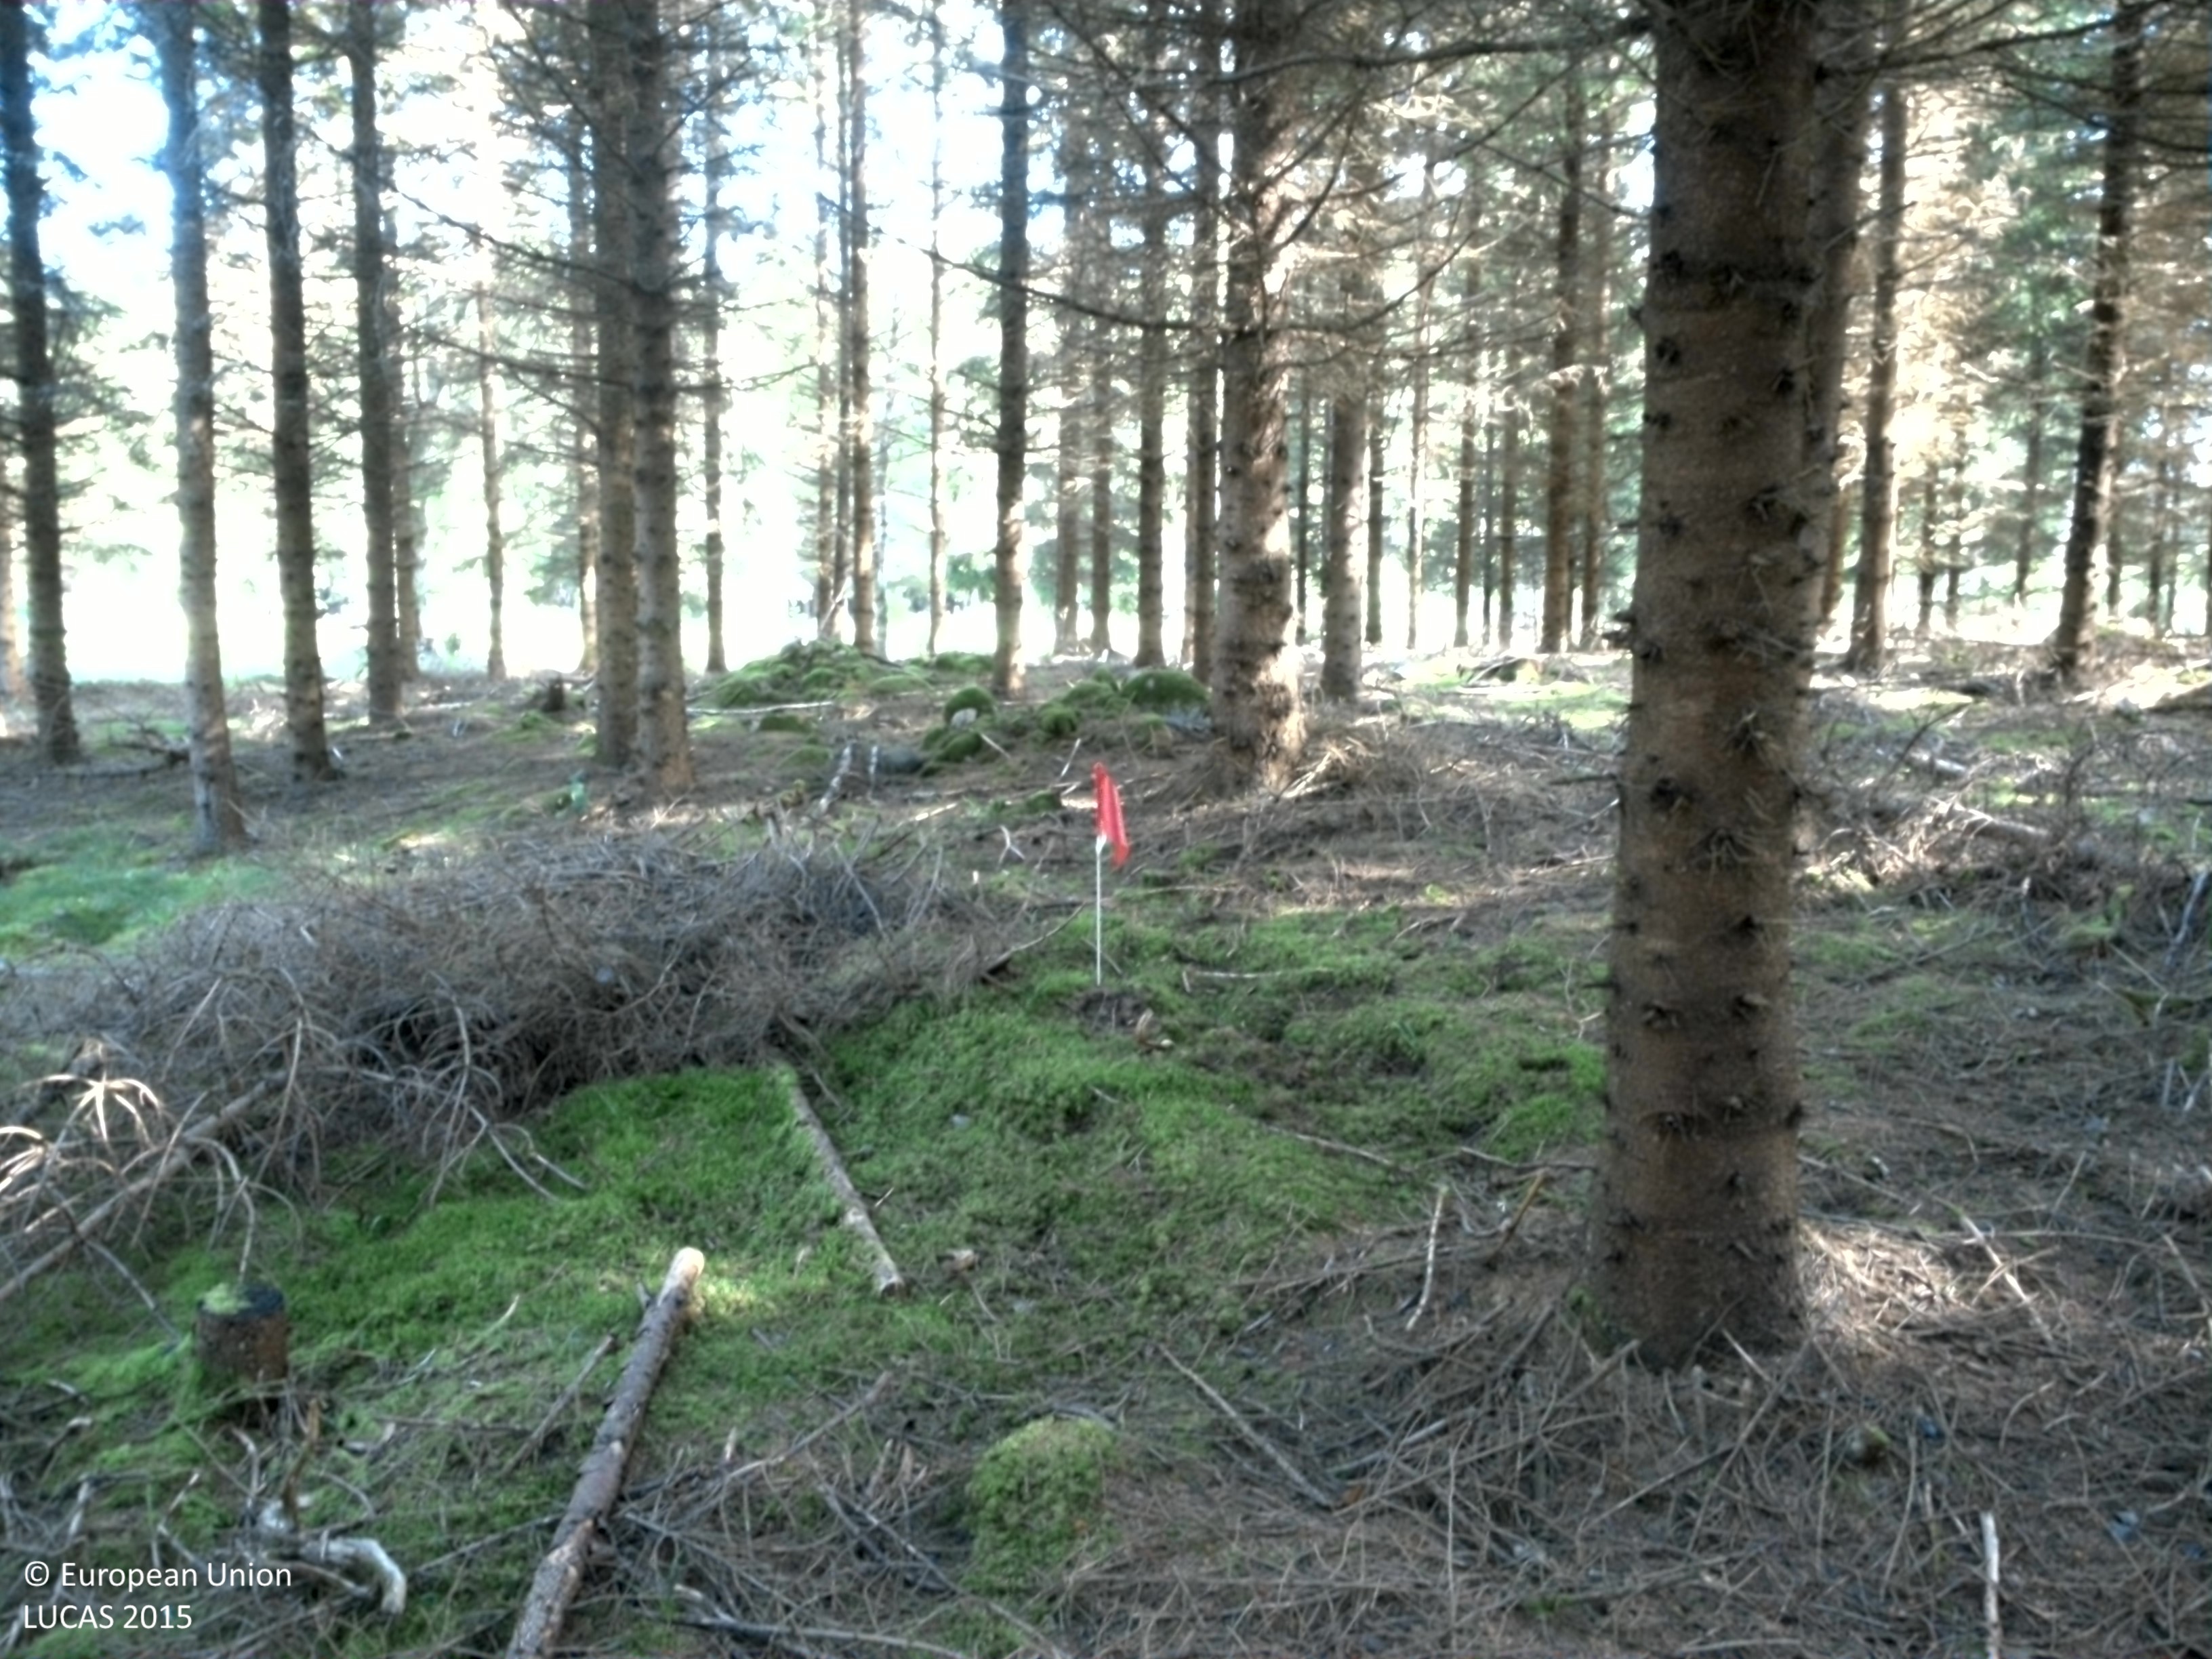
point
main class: Woodland
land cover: Spruce dominated coniferous woodland
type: boreal forest
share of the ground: > 75 %
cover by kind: coniferous forest trees 90 %, lichens and mosses 5 %, unconsolidated bare surface 5 %
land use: Forestry
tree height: > 5 m
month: August
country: SE
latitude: 58.1779
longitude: 13.3443
